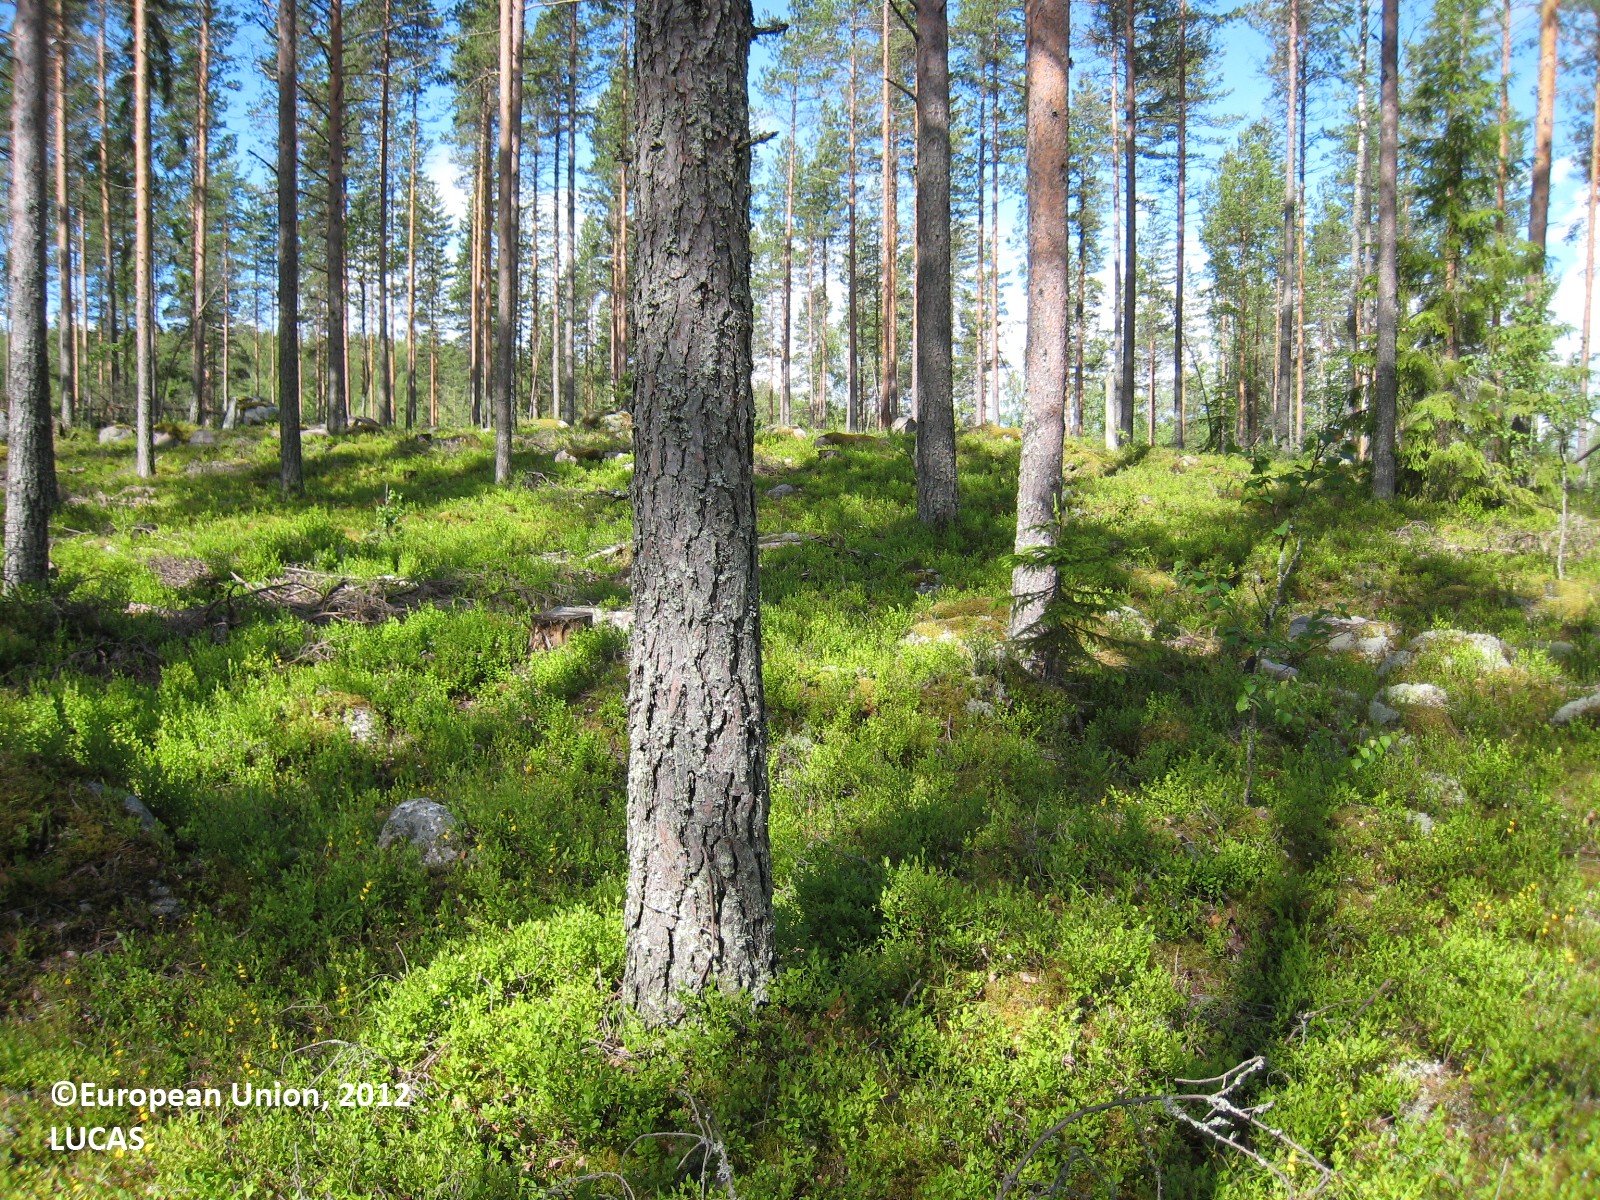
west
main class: Woodland
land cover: Pine dominated coniferous woodland
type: boreal forest
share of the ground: 25 - 50 %
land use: Forestry
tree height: > 5 m
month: June
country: FI
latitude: 62.0968
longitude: 25.8503
